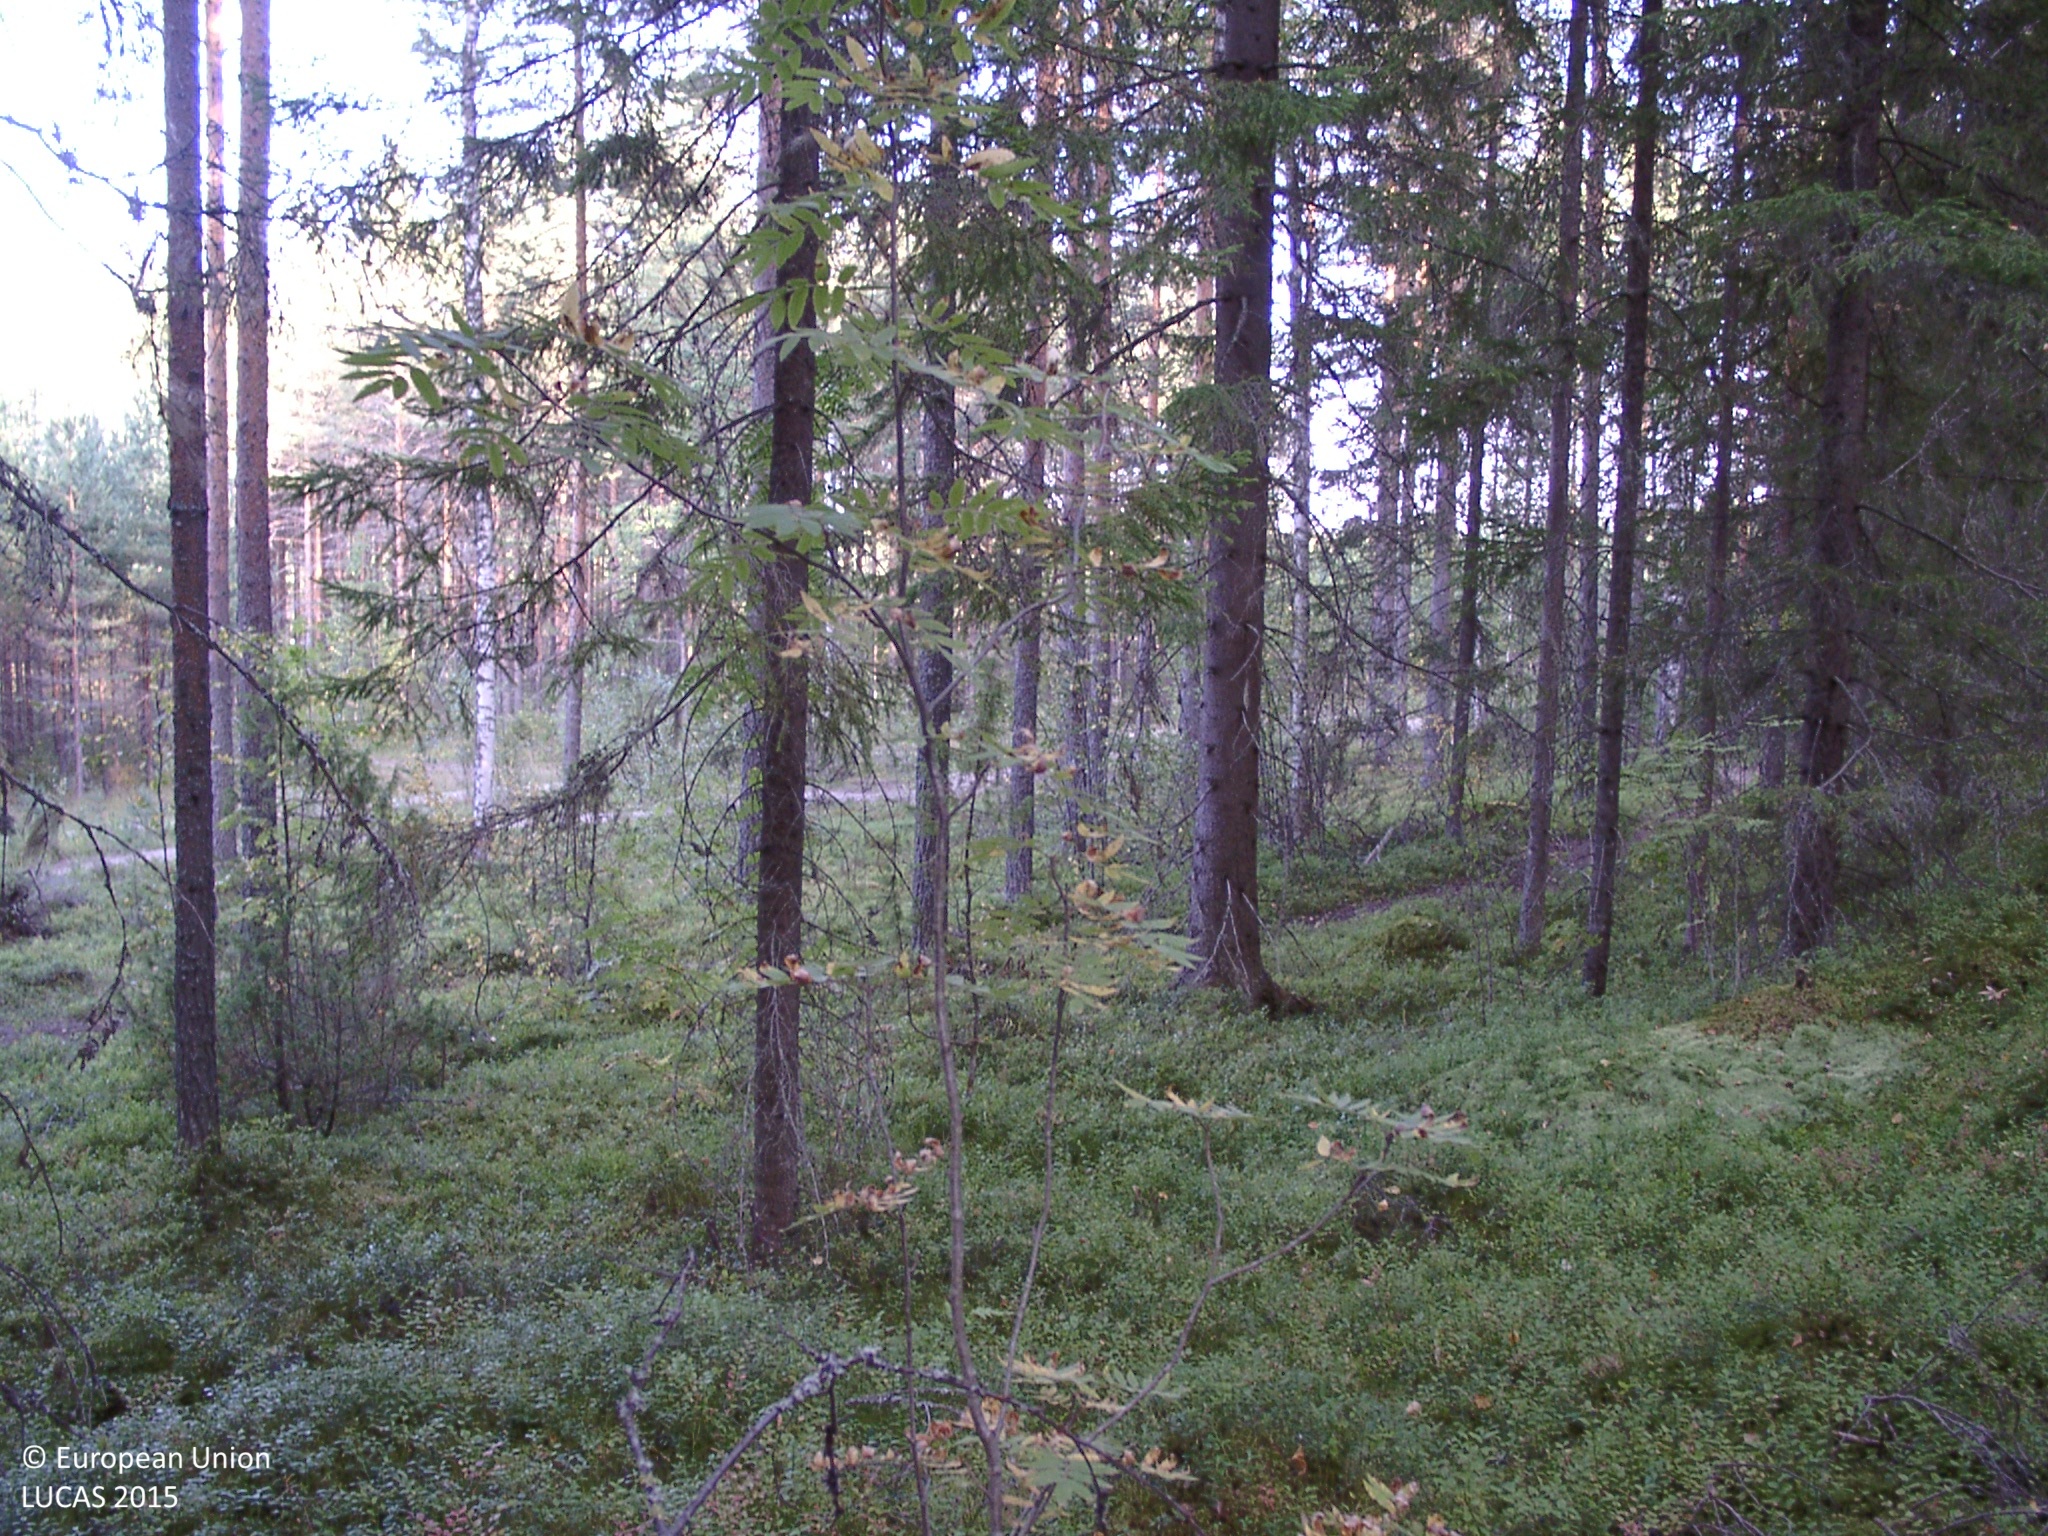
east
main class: Woodland
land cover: Spruce dominated mixed woodland
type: boreal forest
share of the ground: 50 - 75 %
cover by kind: coniferous forest trees 45 %, broadleaved forest trees 20 %, shrubs 20 %, lichens and mosses 15 %
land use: Forestry
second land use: Sport
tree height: > 5 m
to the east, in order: Spruce dominated mixed woodland; Tracks; Pine dominated coniferous woodland; Tracks; Electric lines; Shrubland with sparse tree cover; Tracks; Groves; Pine dominated coniferous woodland; Tracks; Pine dominated coniferous woodland
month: August
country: FI
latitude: 61.8972
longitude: 25.1231
